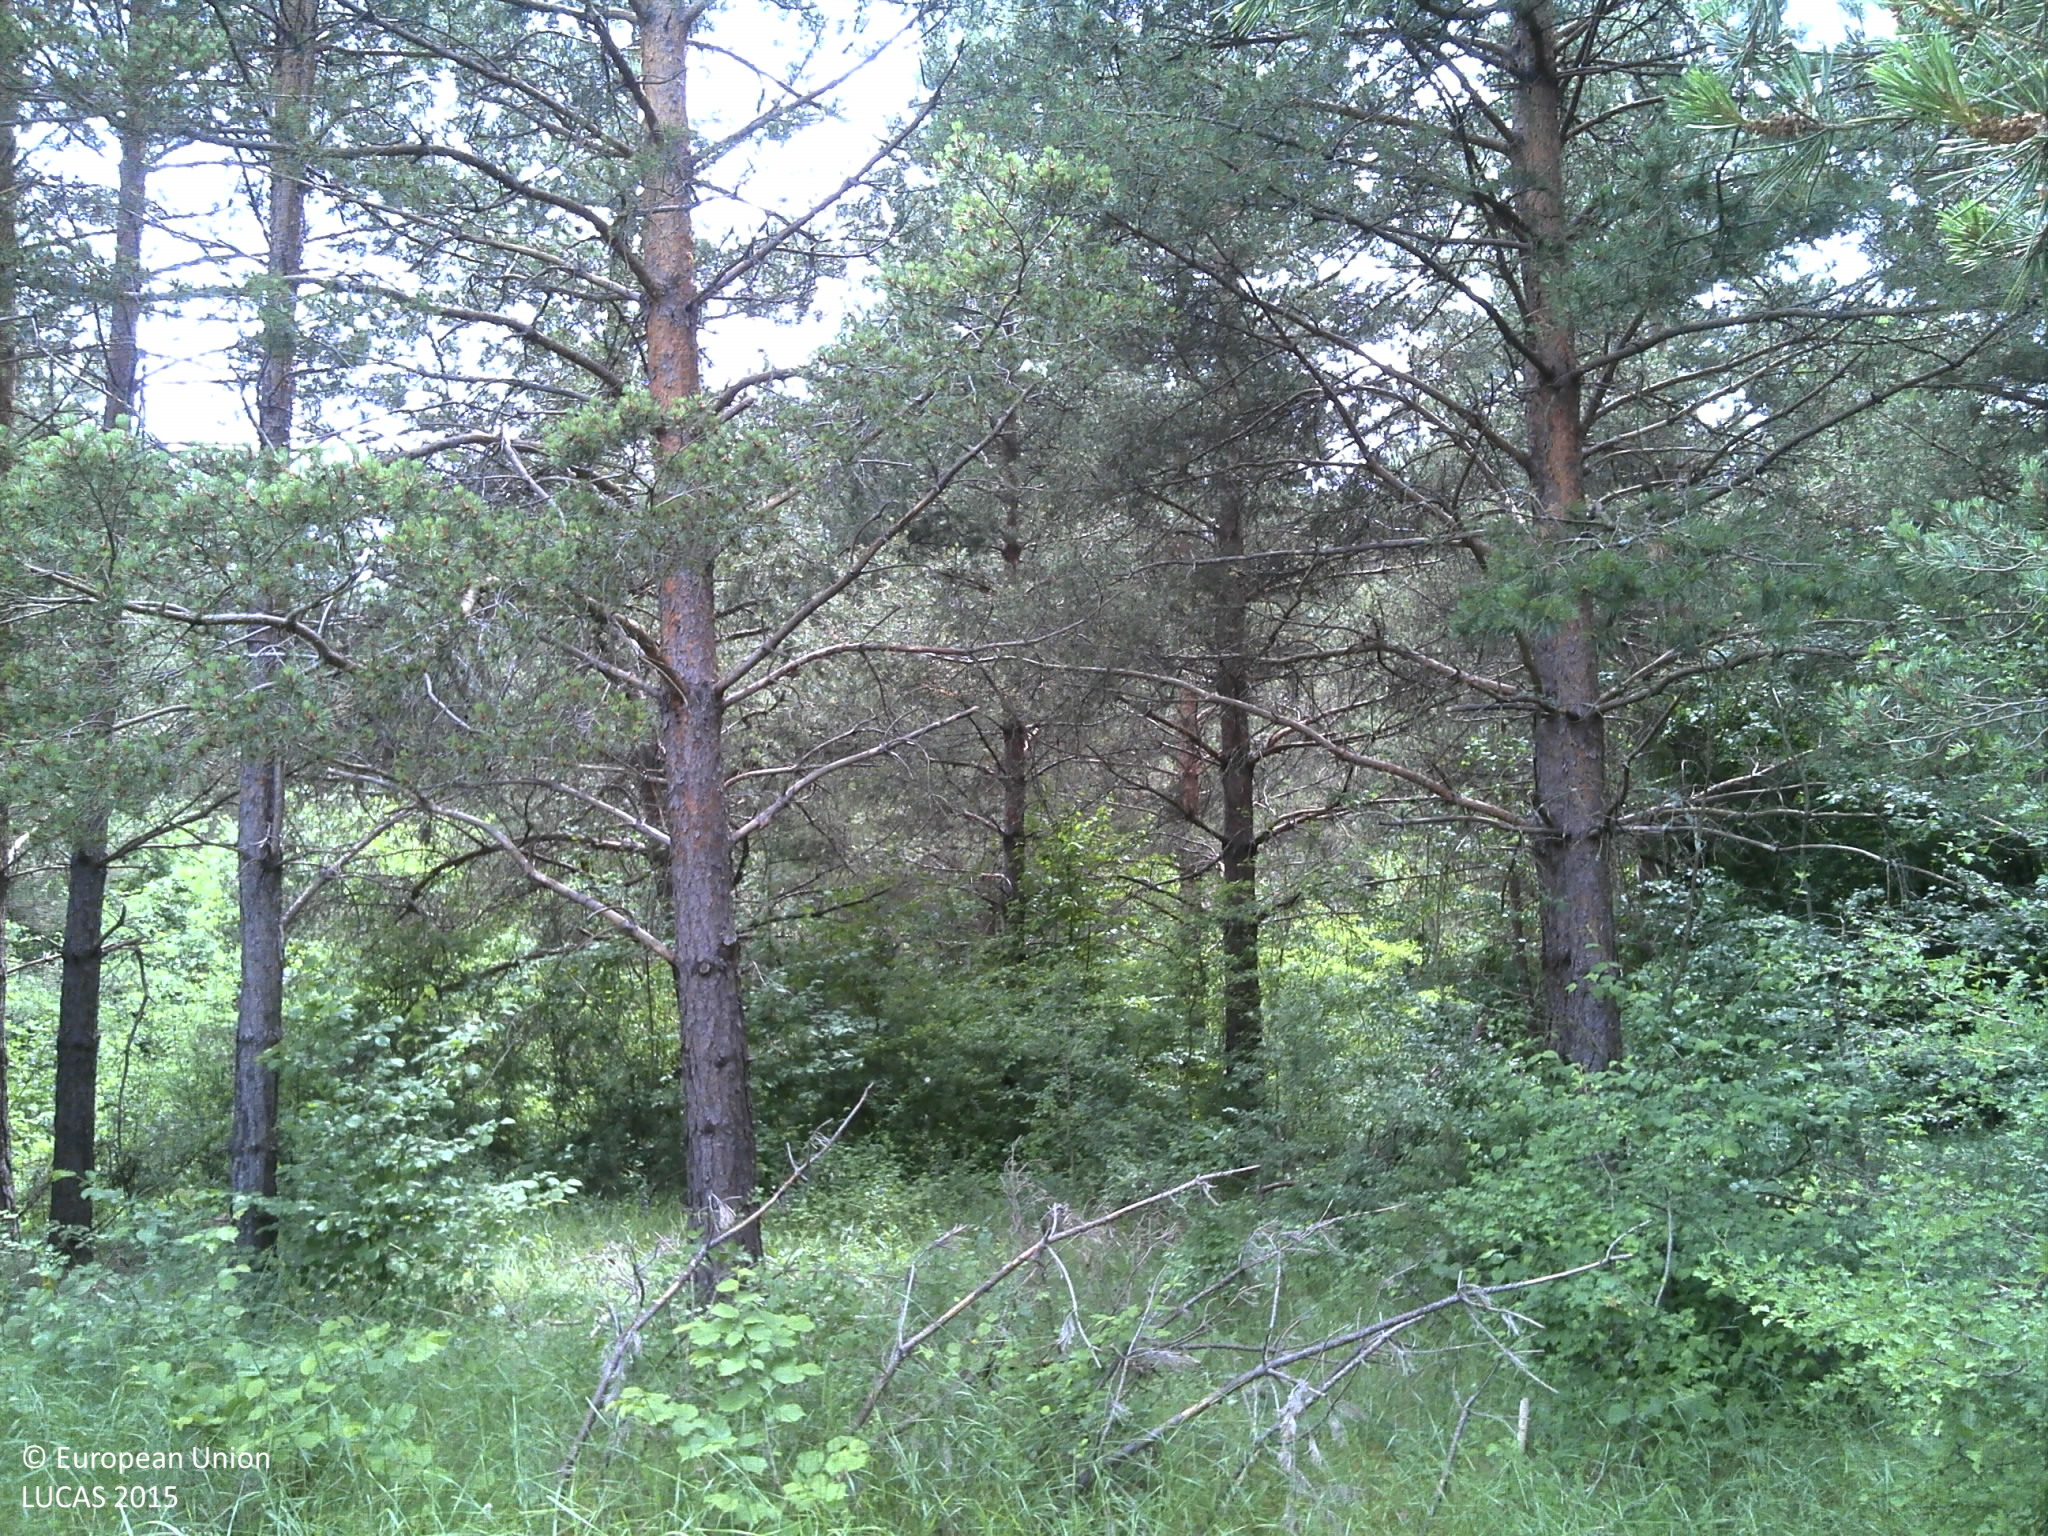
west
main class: Woodland
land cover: Pine dominated coniferous woodland
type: hemiboreal forest and nemoral coniferous forest and mixed broadleaved-coniferous forest
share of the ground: 50 - 75 %
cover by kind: coniferous forest trees 50 %, herbaceous plants 40 %, broadleaved forest trees 10 %
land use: Semi-natural and natural areas not in use
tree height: > 5 m
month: June
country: HR
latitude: 44.4804
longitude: 16.0665
